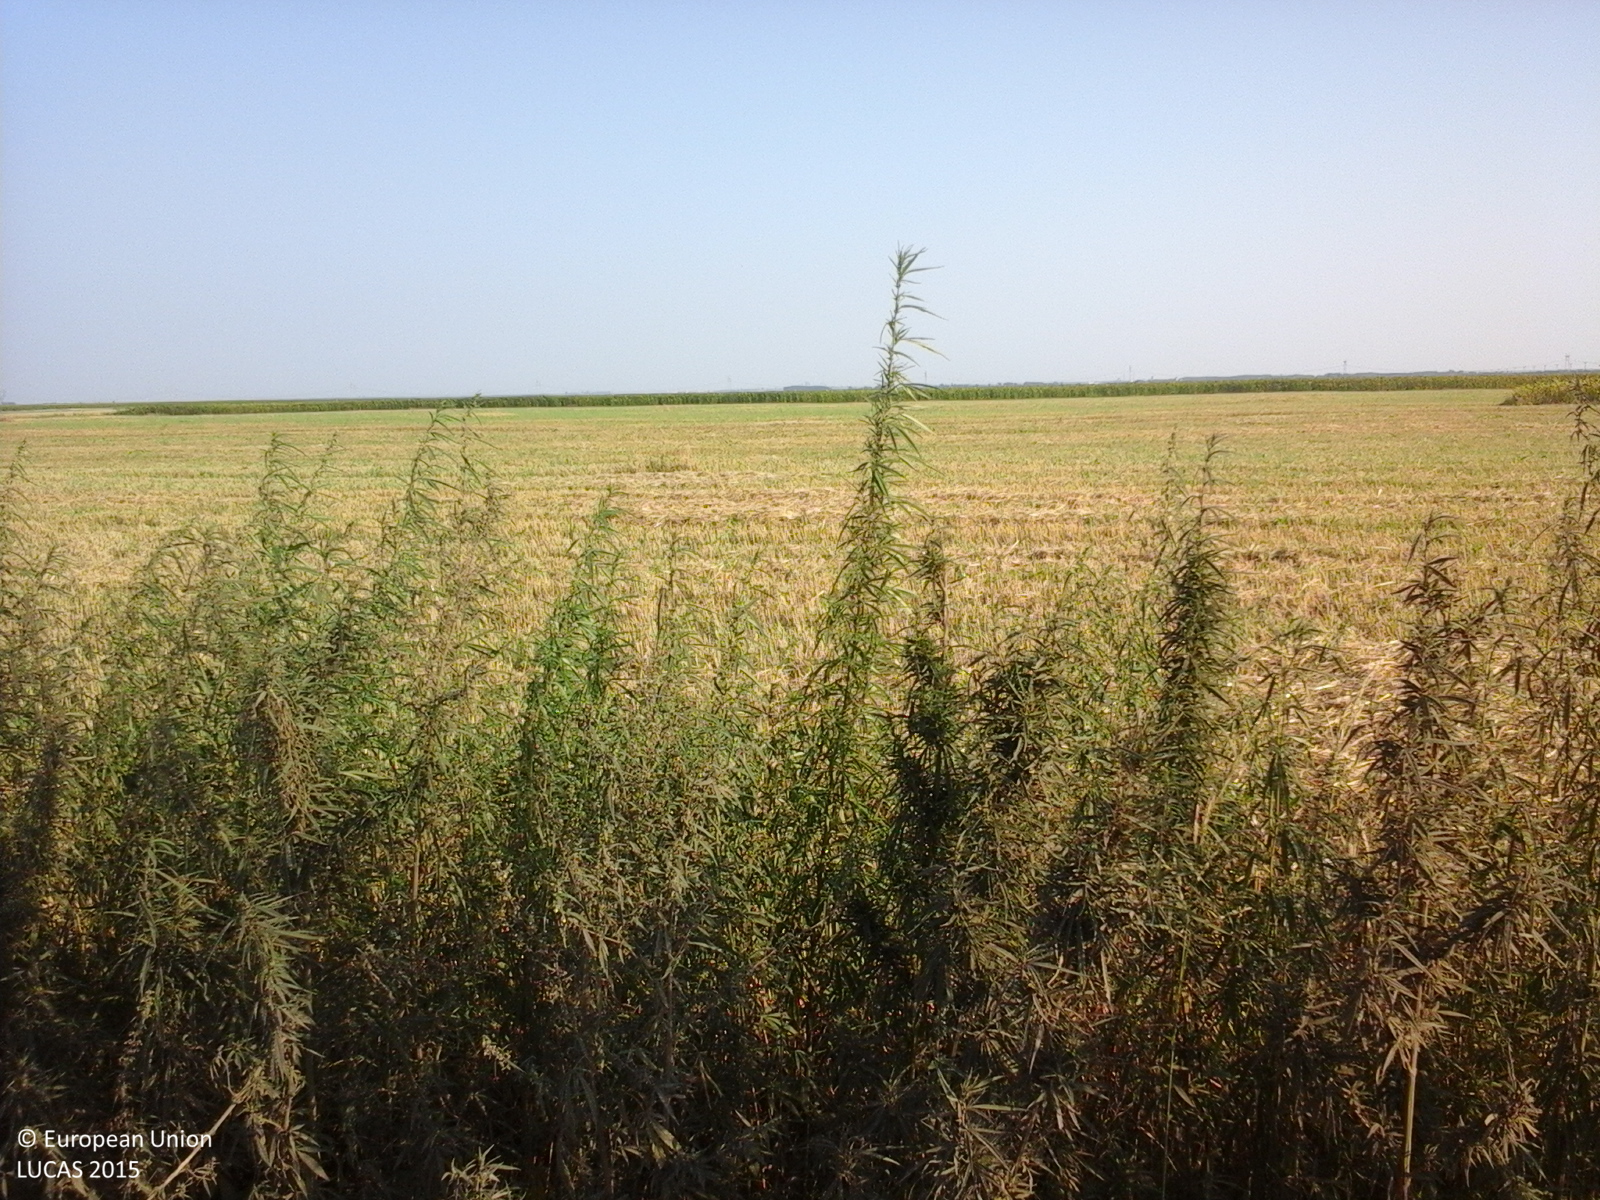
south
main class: Cropland
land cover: Maize
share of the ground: > 75 %
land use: Agriculture (excluding fallow land and kitchen gardens)
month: July
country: RO
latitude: 44.6648
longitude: 27.3308
